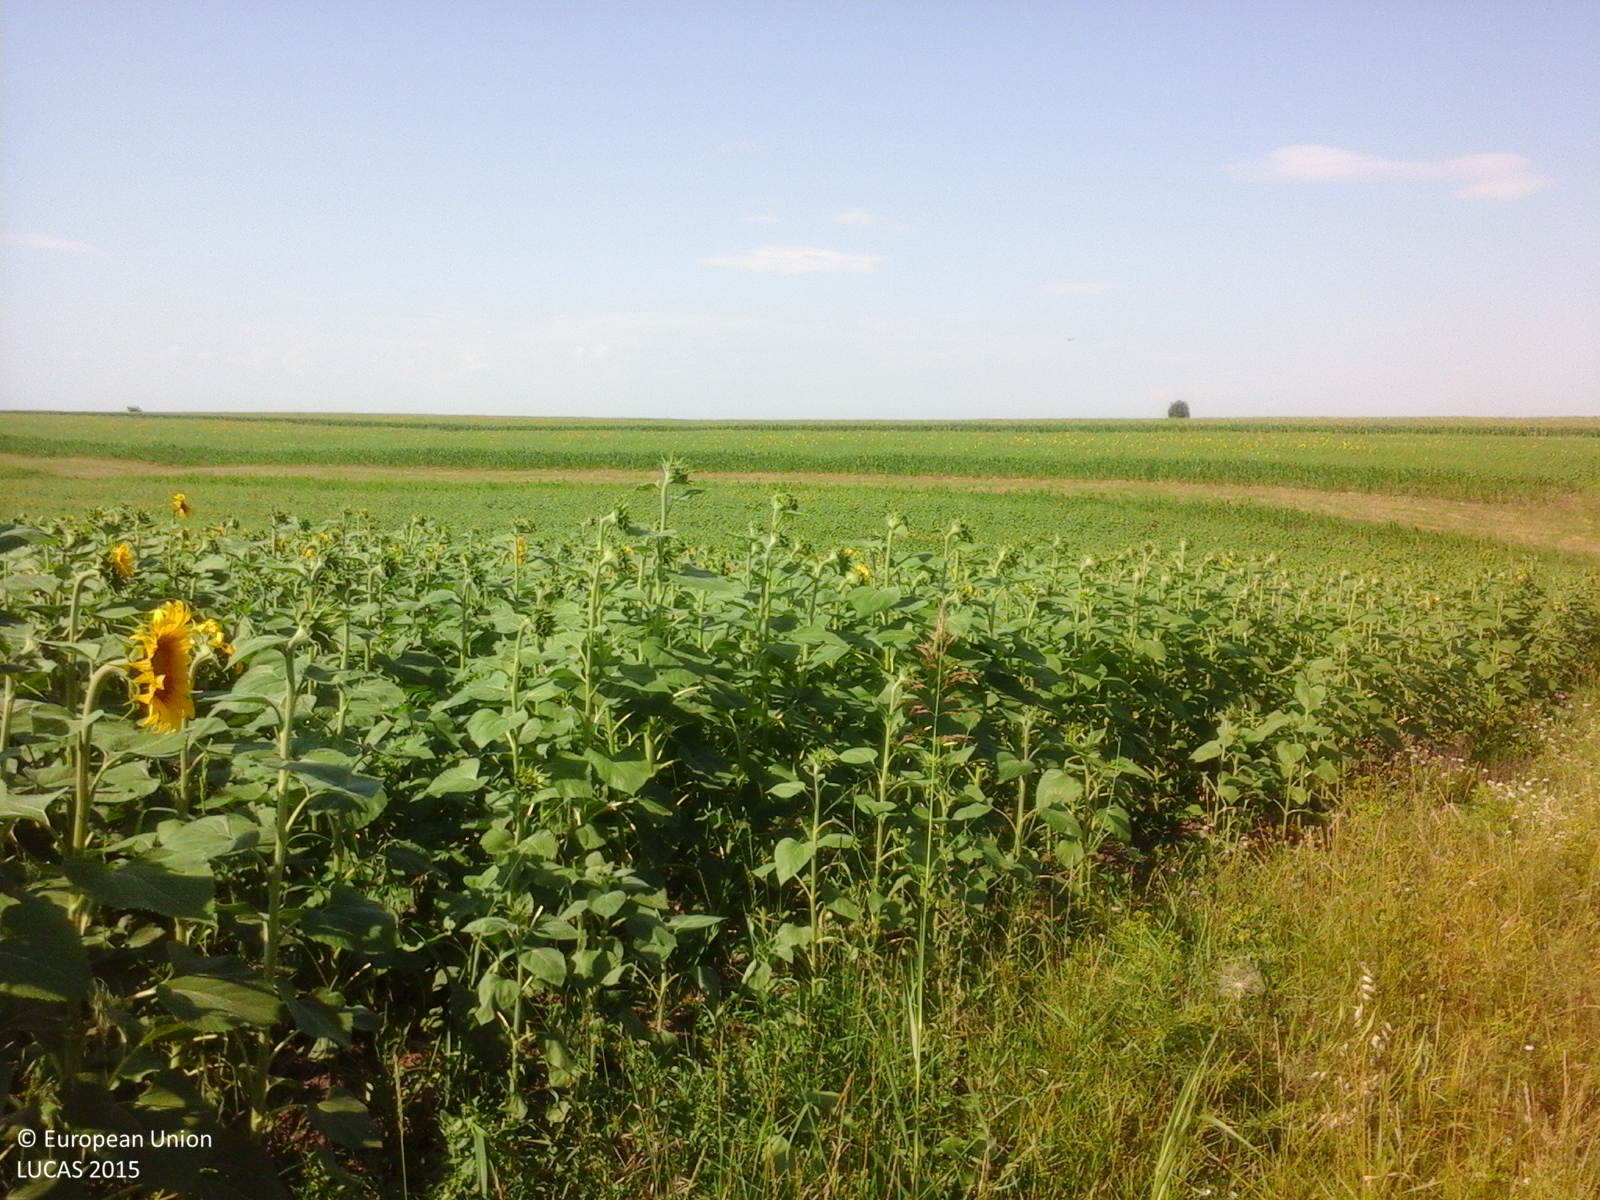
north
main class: Cropland
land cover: Sunflower
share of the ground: > 75 %
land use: Agriculture (excluding fallow land and kitchen gardens)
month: July
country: RO
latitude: 44.3918
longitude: 24.5967
